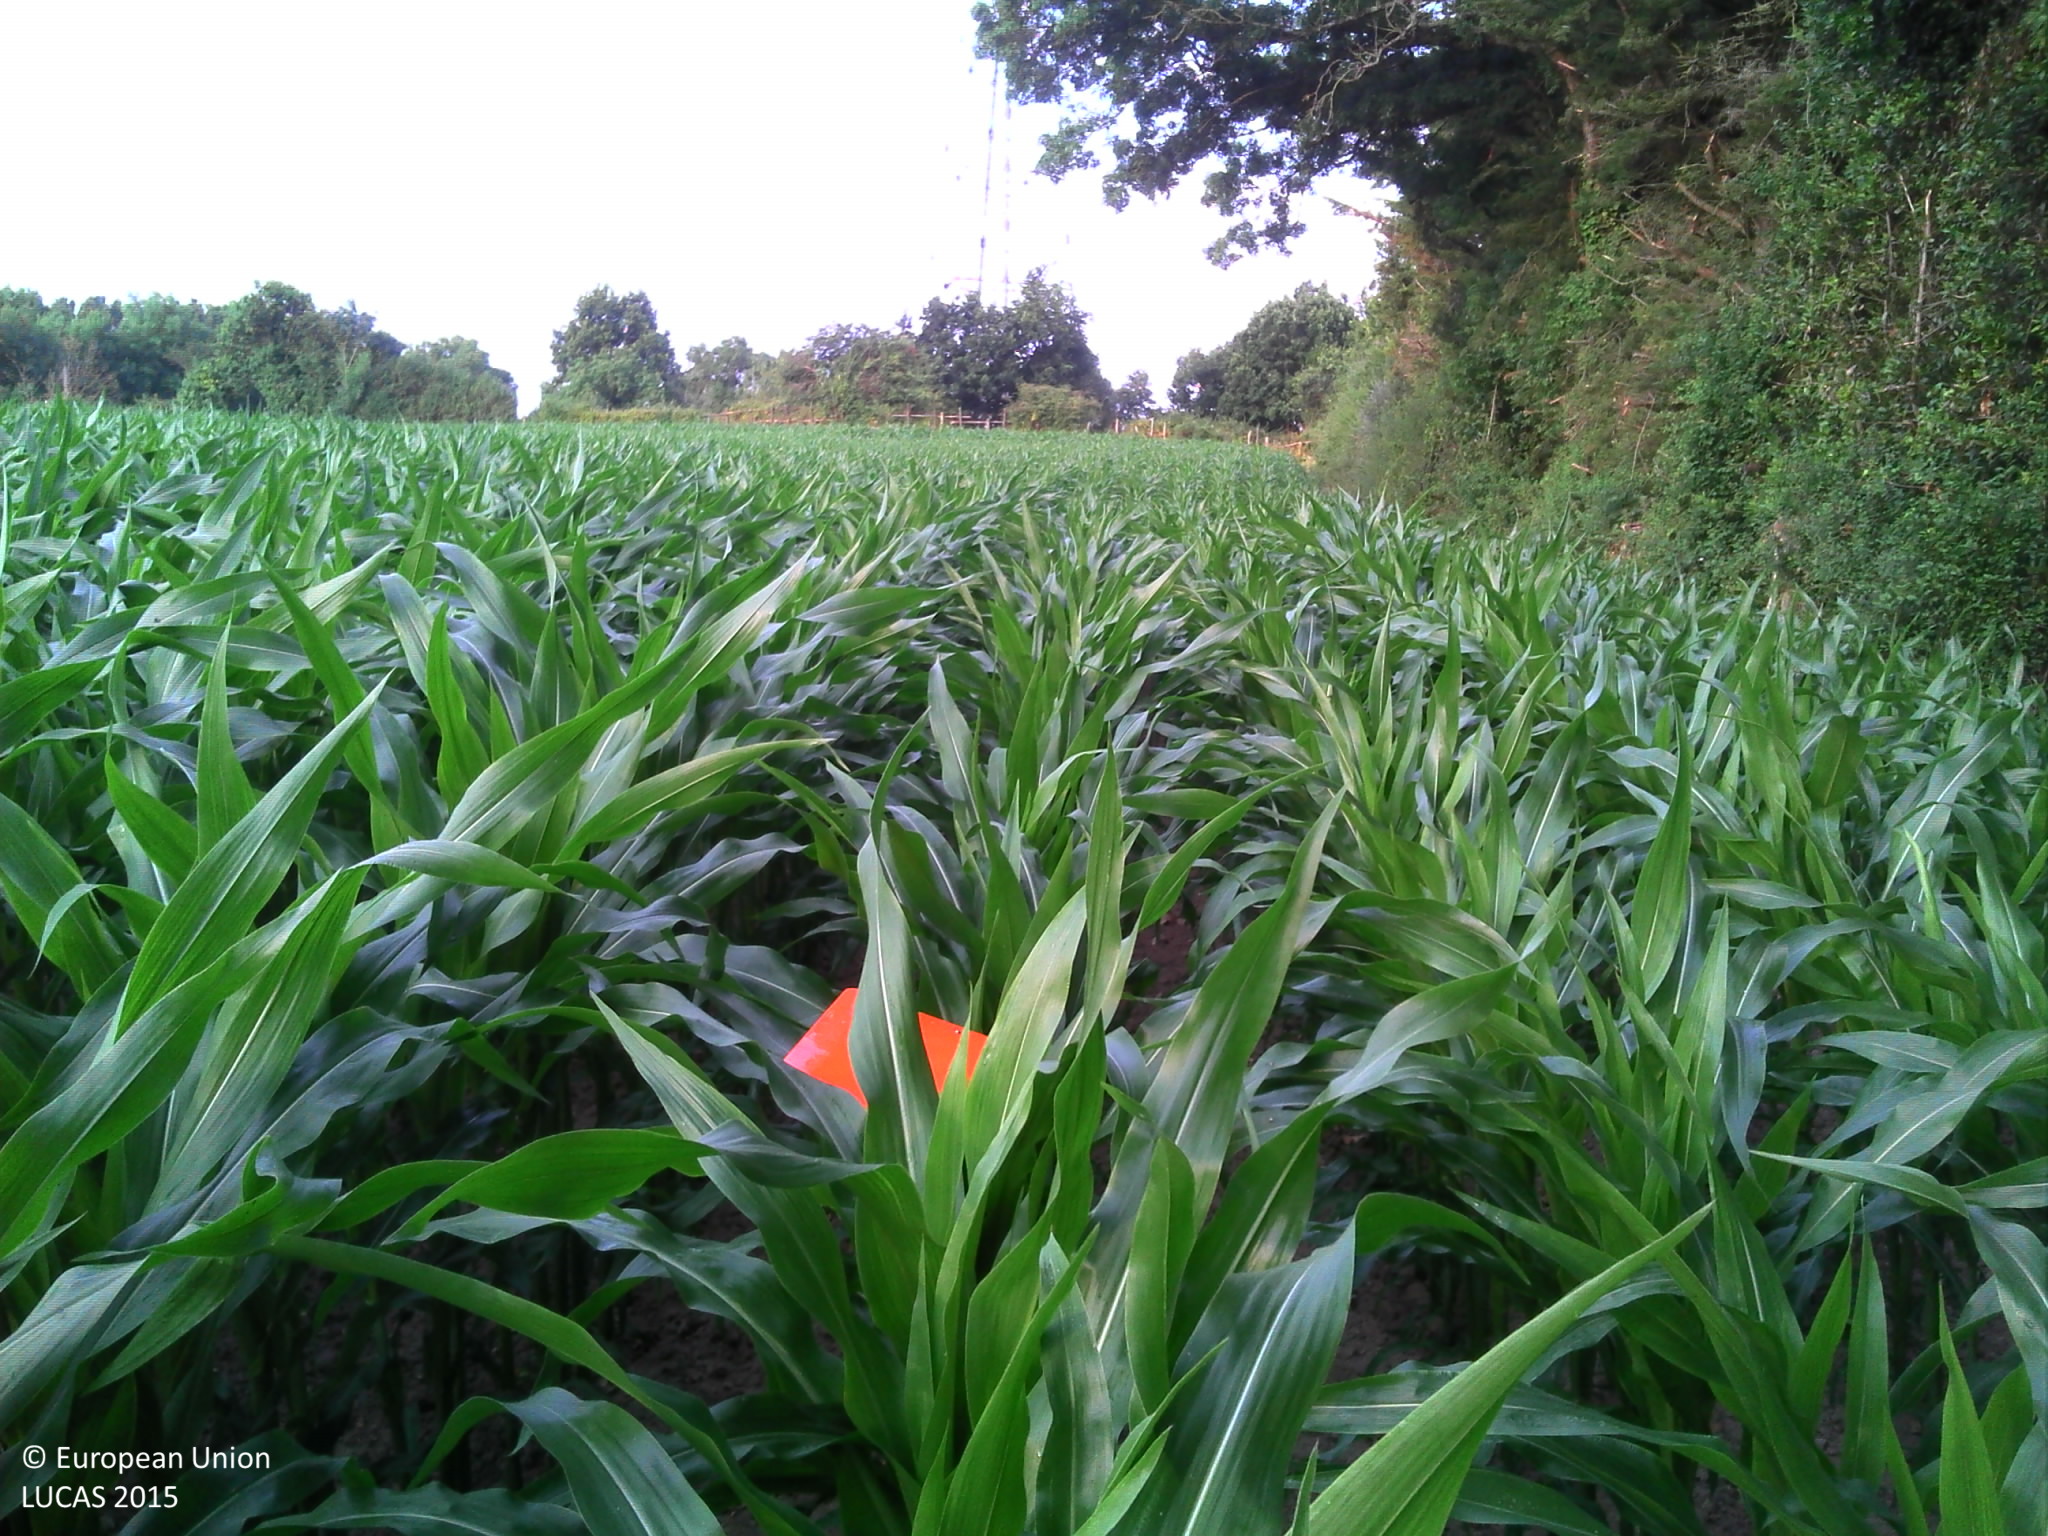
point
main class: Cropland
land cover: Maize
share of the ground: > 75 %
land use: Agriculture (excluding fallow land and kitchen gardens)
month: July
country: FR
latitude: 47.2457
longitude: -1.7638
